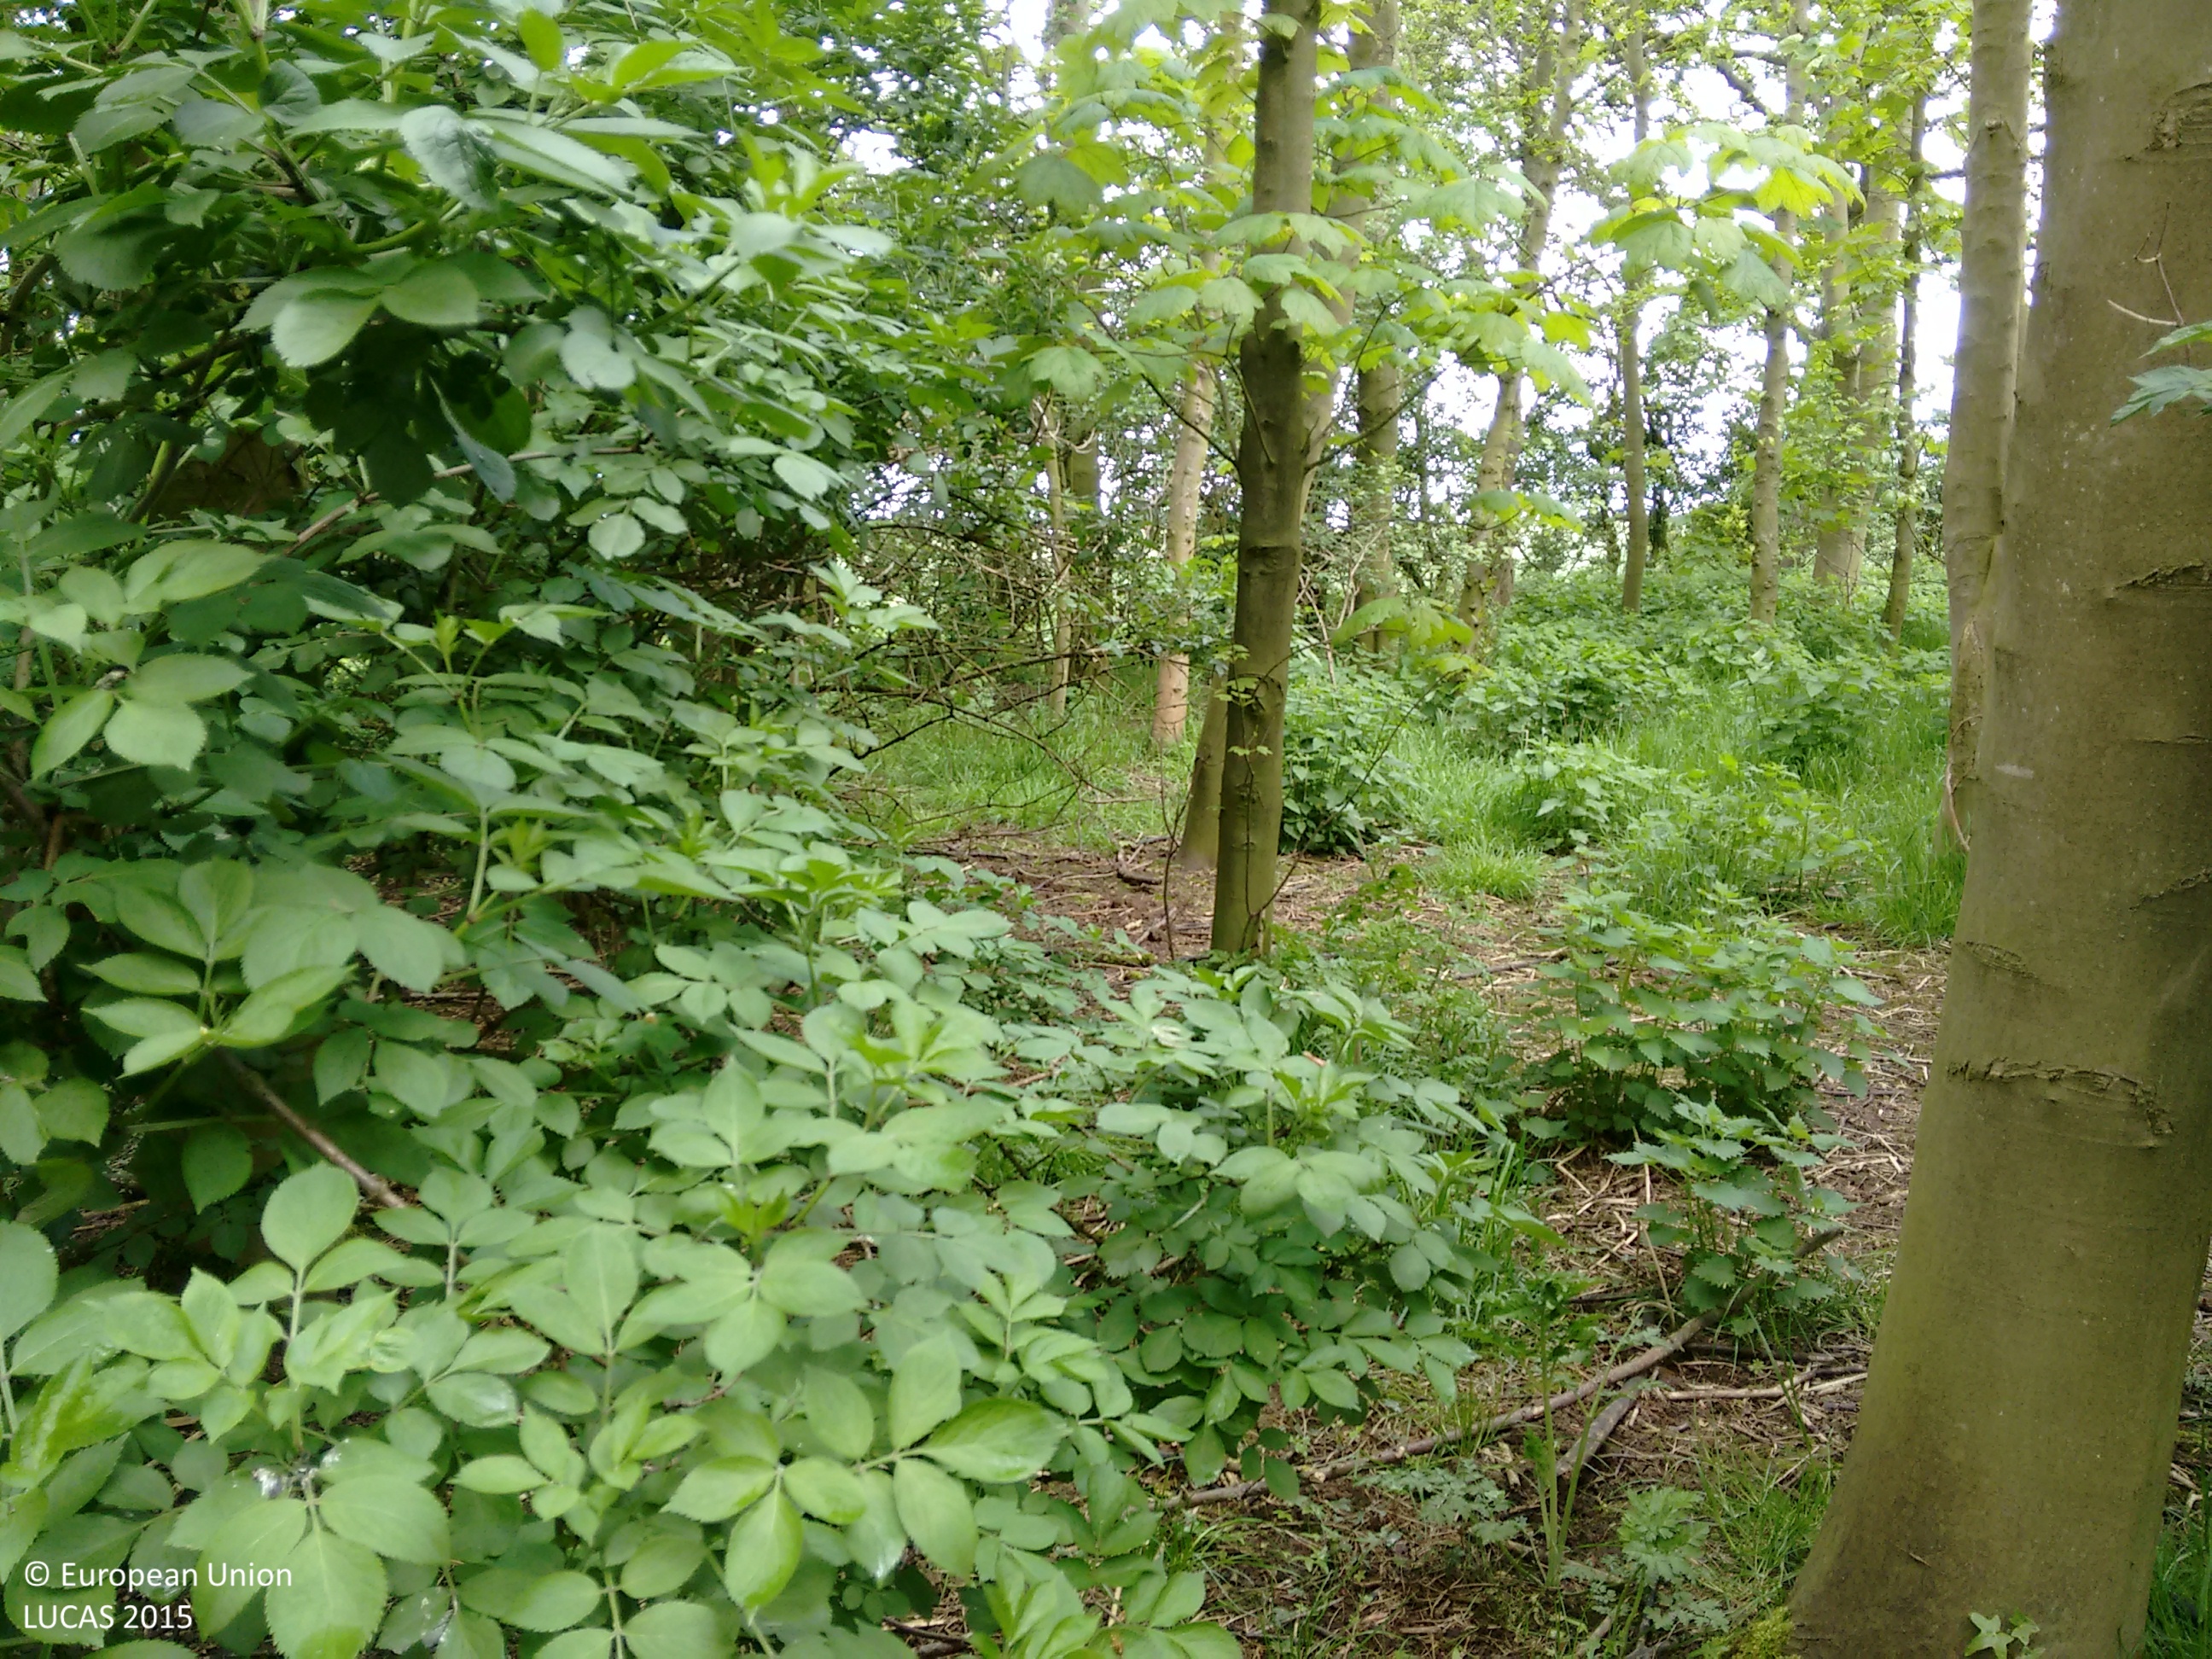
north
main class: Woodland
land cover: Broadleaved woodland
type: mesophytic deciduous forest
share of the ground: > 75 %
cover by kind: broadleaved forest trees 100 %
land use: Agriculture (excluding fallow land and kitchen gardens)
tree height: > 5 m
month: May
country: GB
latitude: 53.1005
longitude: 0.2777
